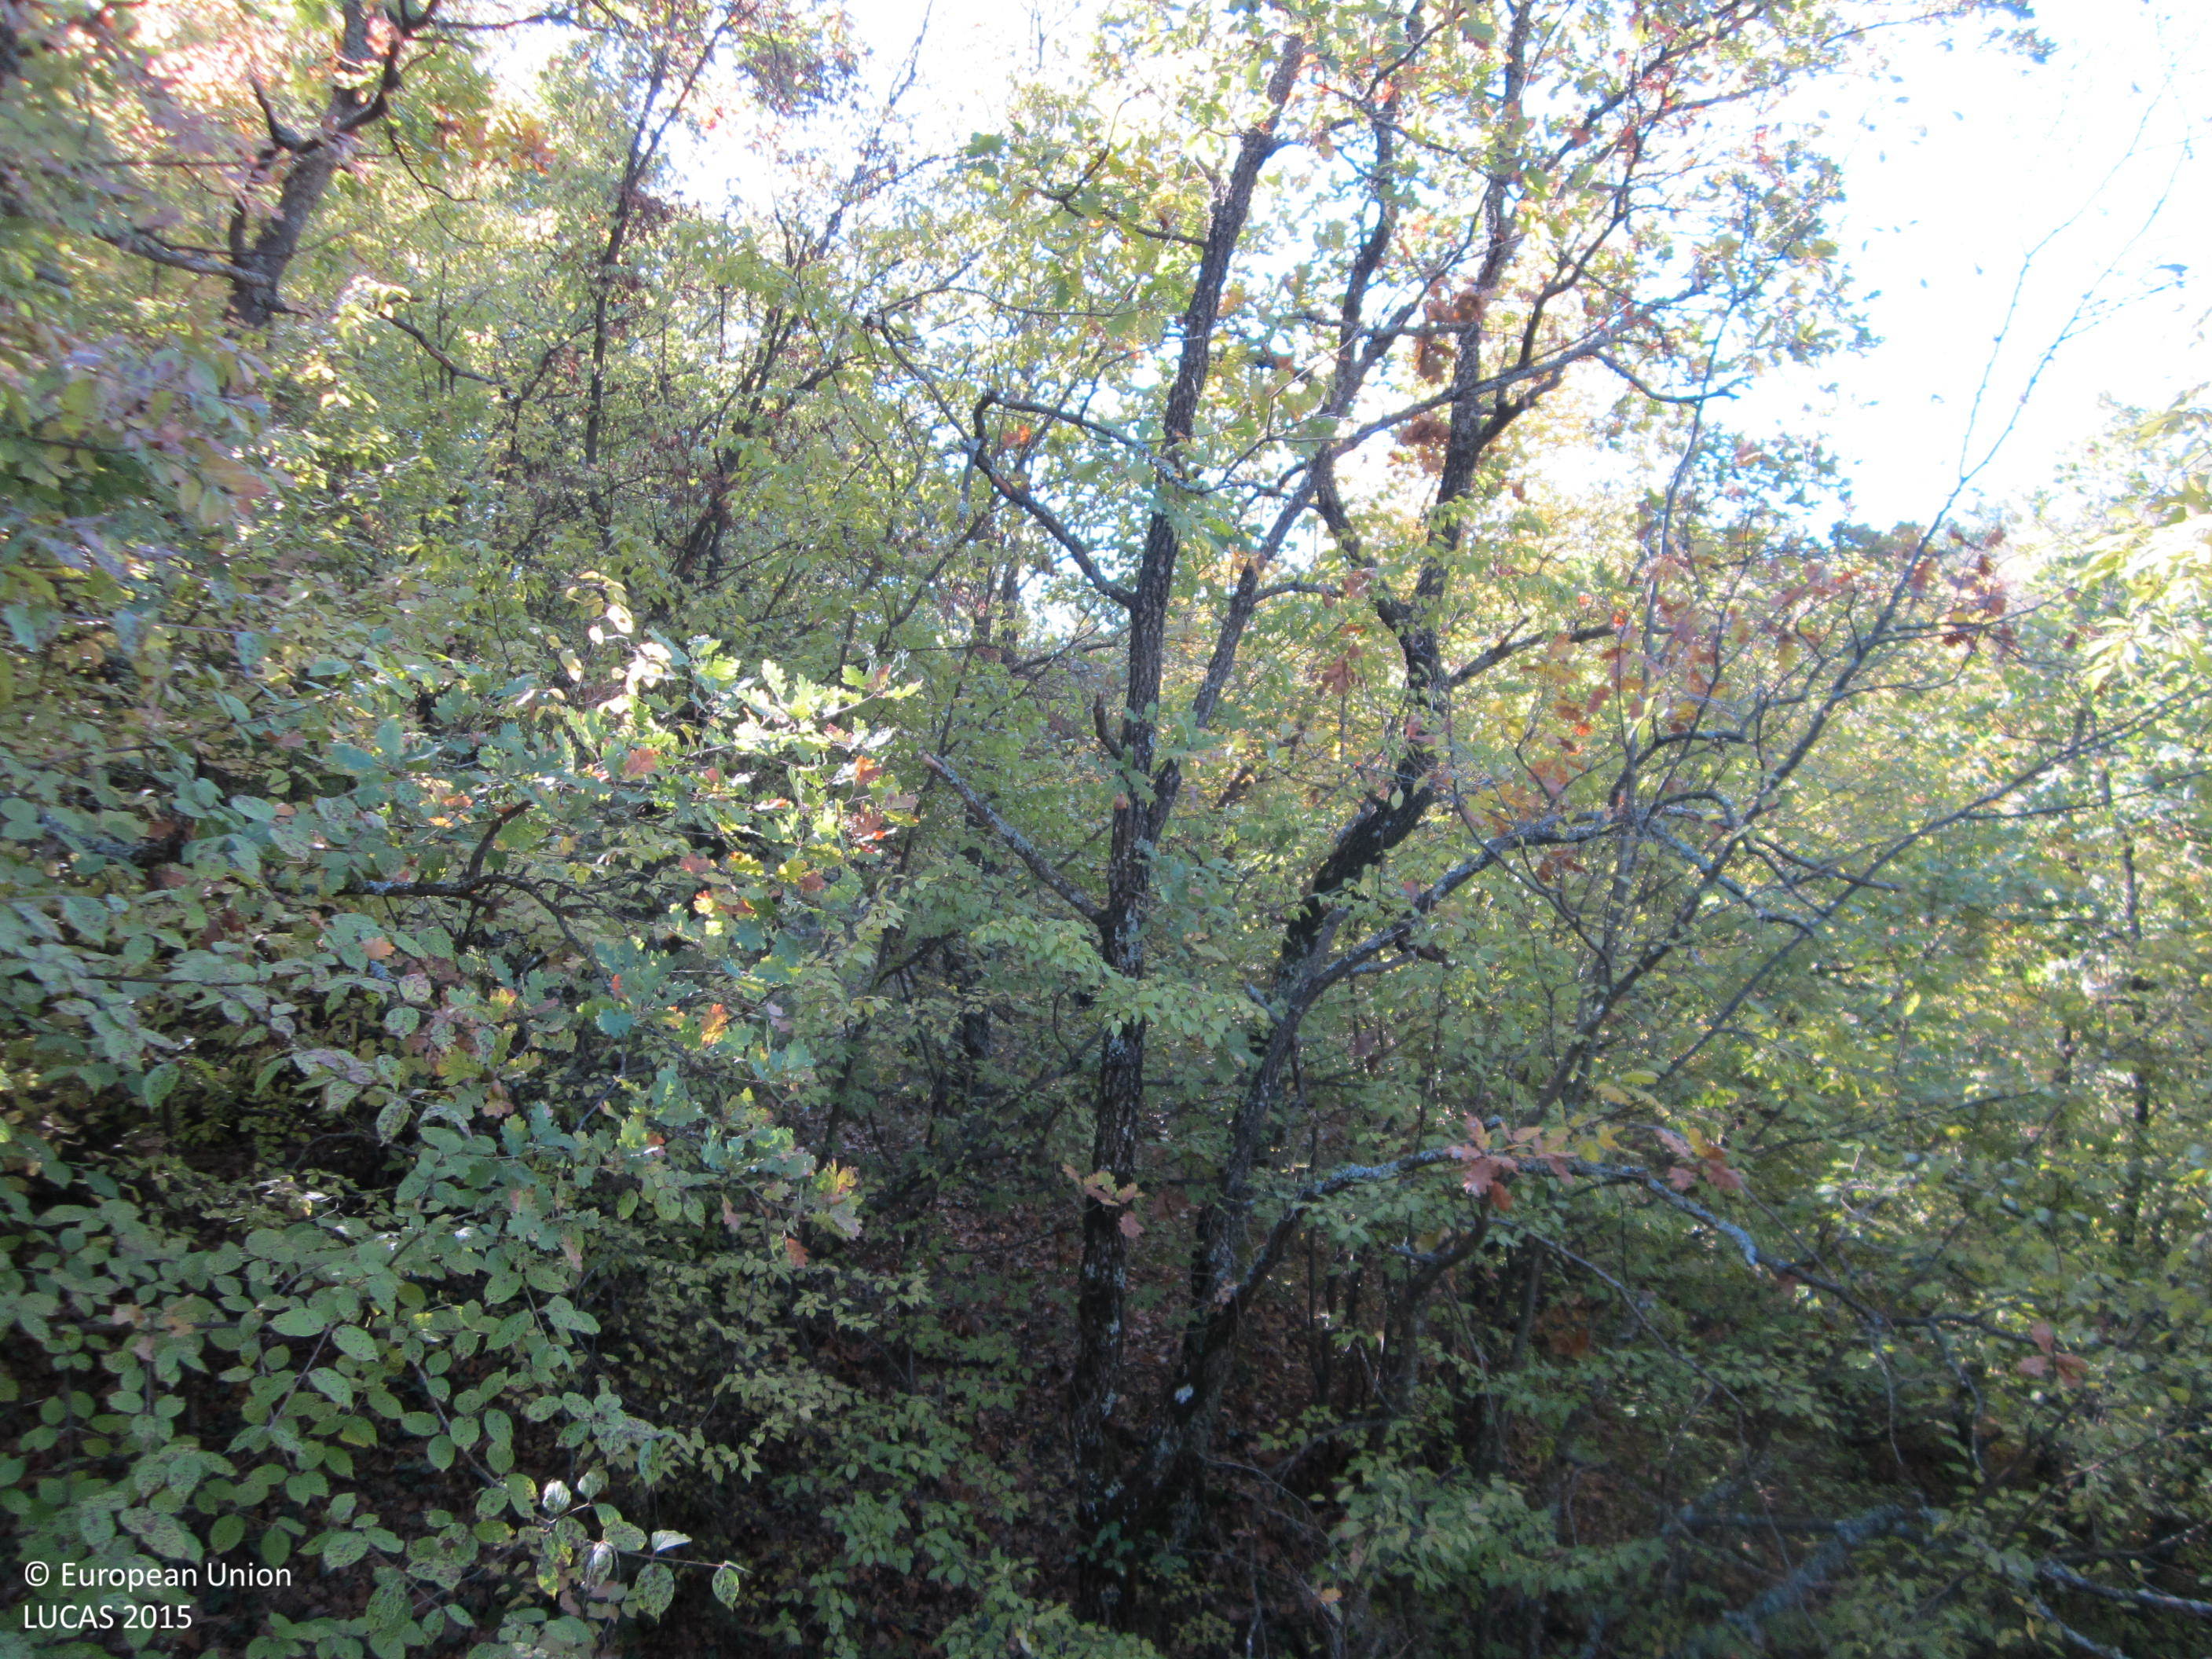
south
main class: Woodland
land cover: Broadleaved woodland
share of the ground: > 75 %
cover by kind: broadleaved forest trees 80 %, herbaceous plants 15 %, shrubs 5 %
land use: Forestry
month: November
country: BG
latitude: 41.4589
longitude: 25.8062
